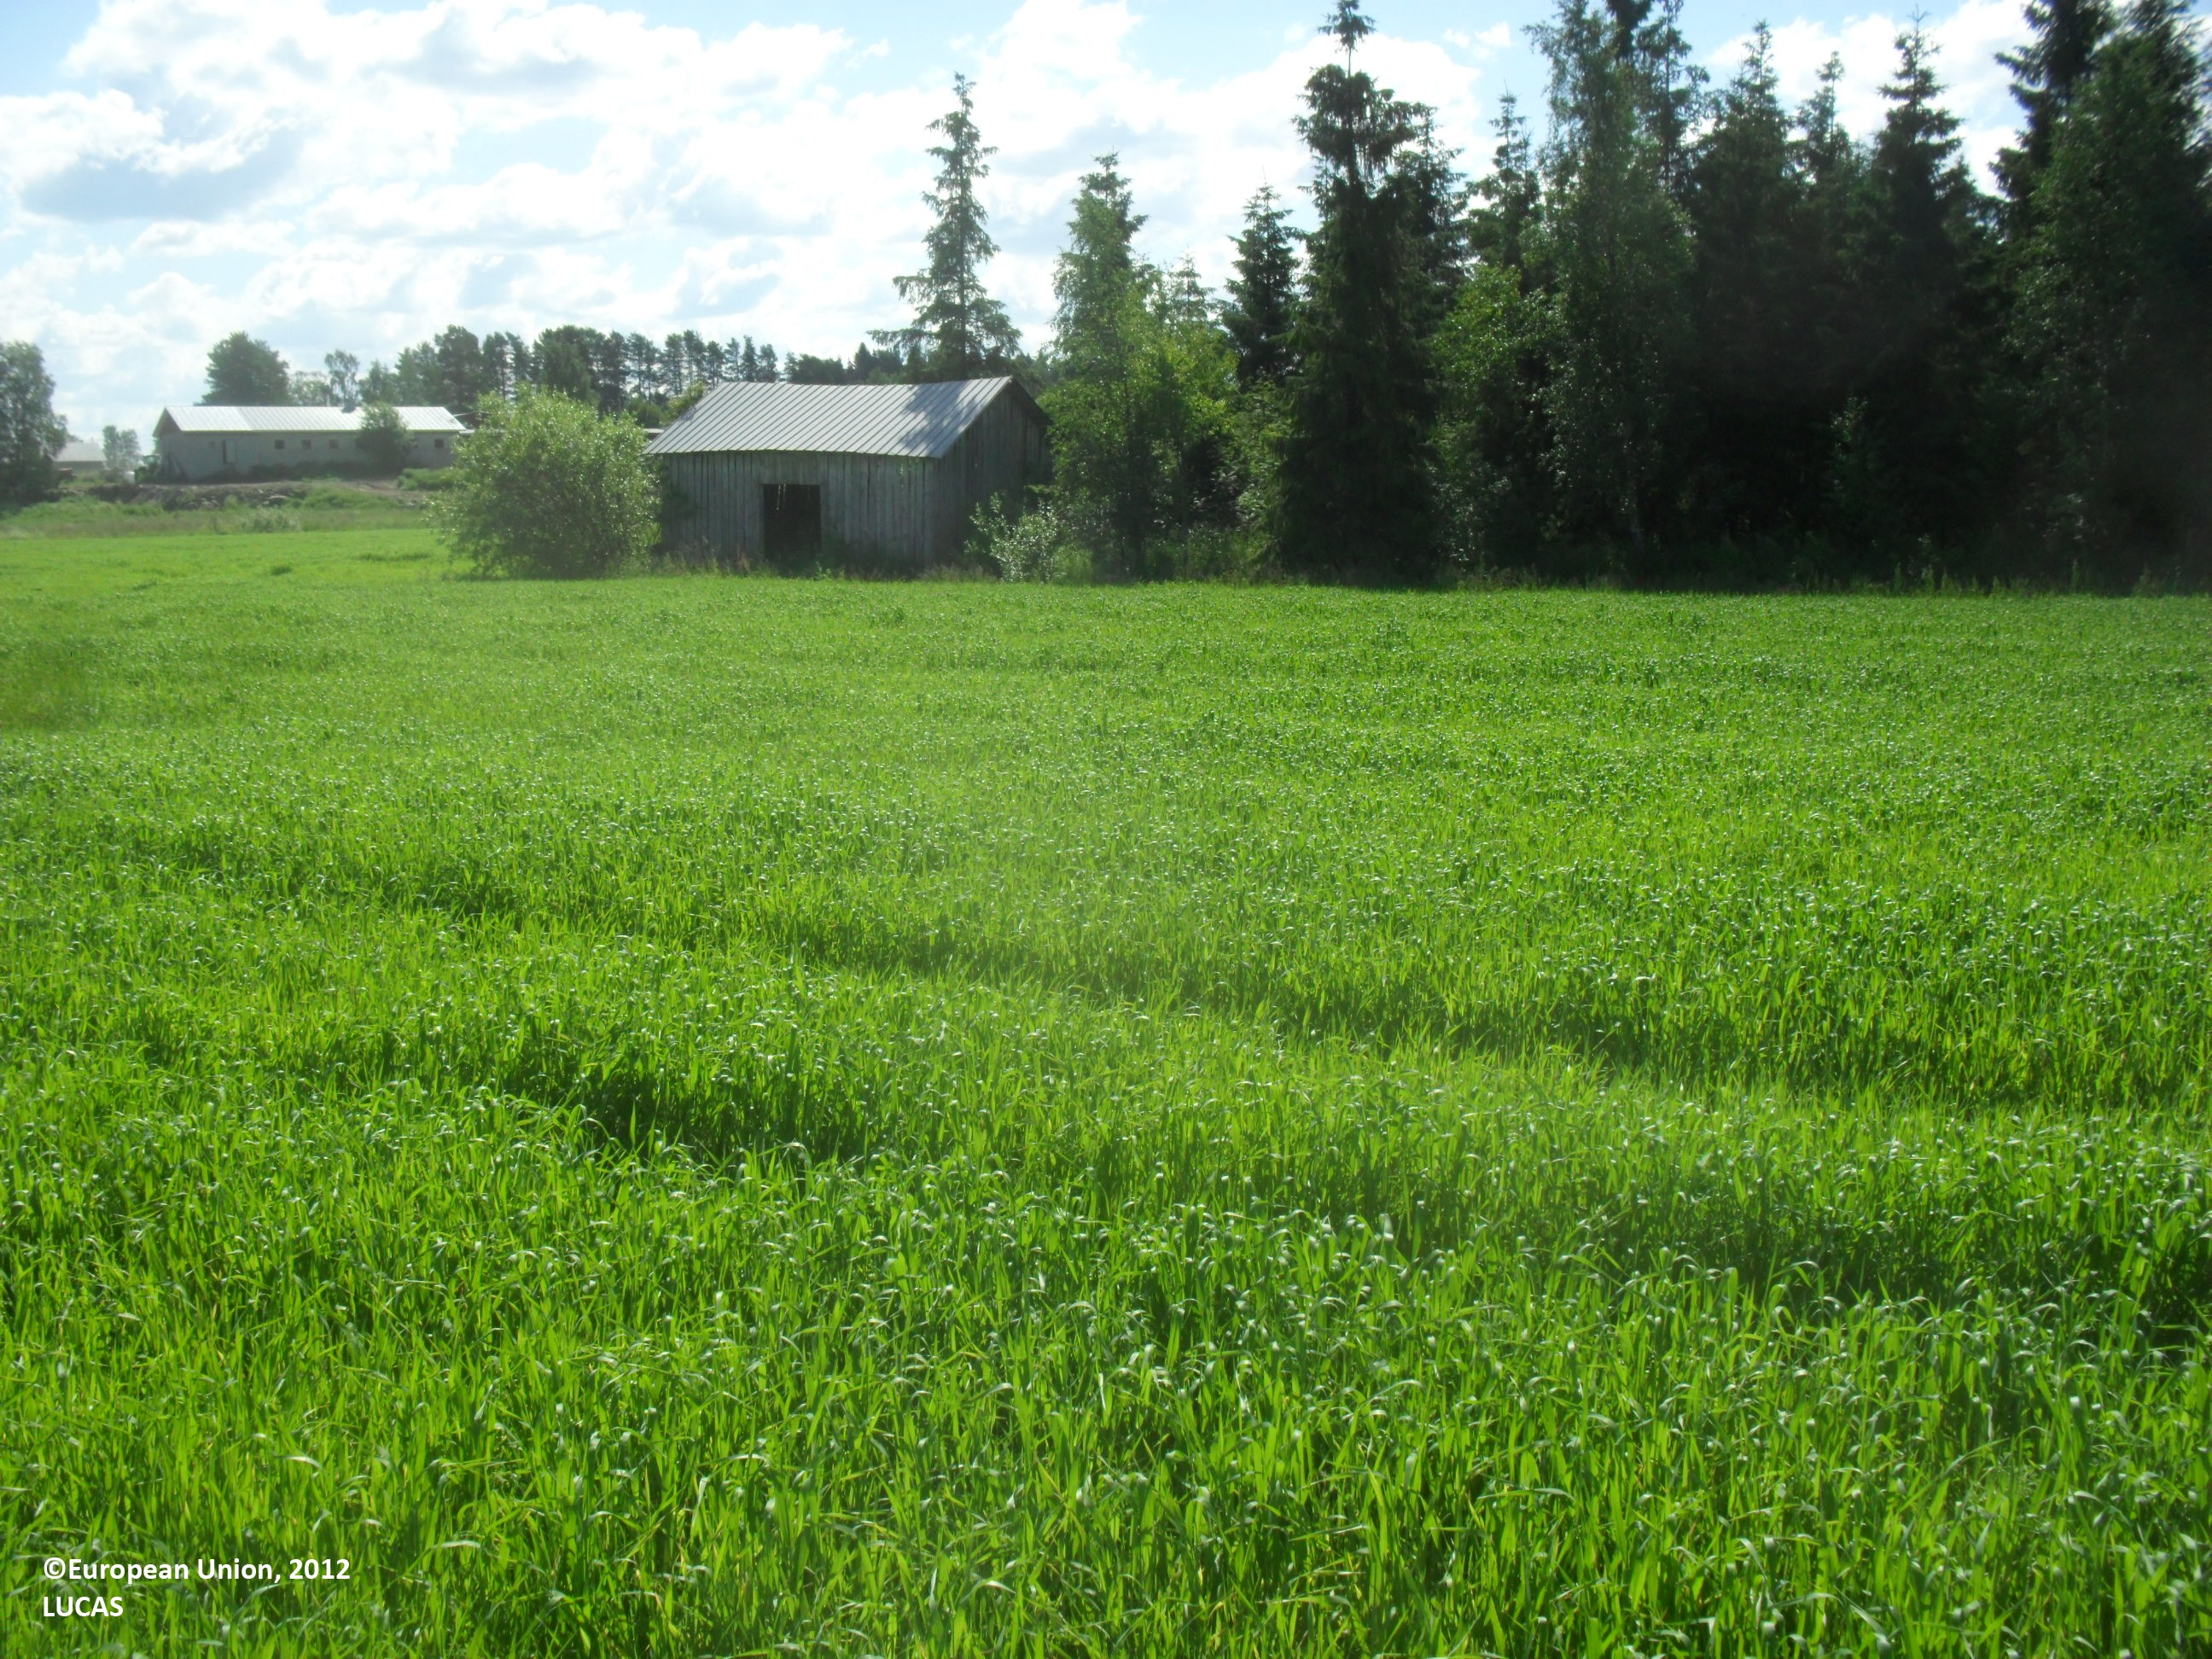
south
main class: Cropland
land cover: Oats
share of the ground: > 75 %
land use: Agriculture (excluding fallow land and kitchen gardens)
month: July
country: FI
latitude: 63.3047
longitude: 23.8972
